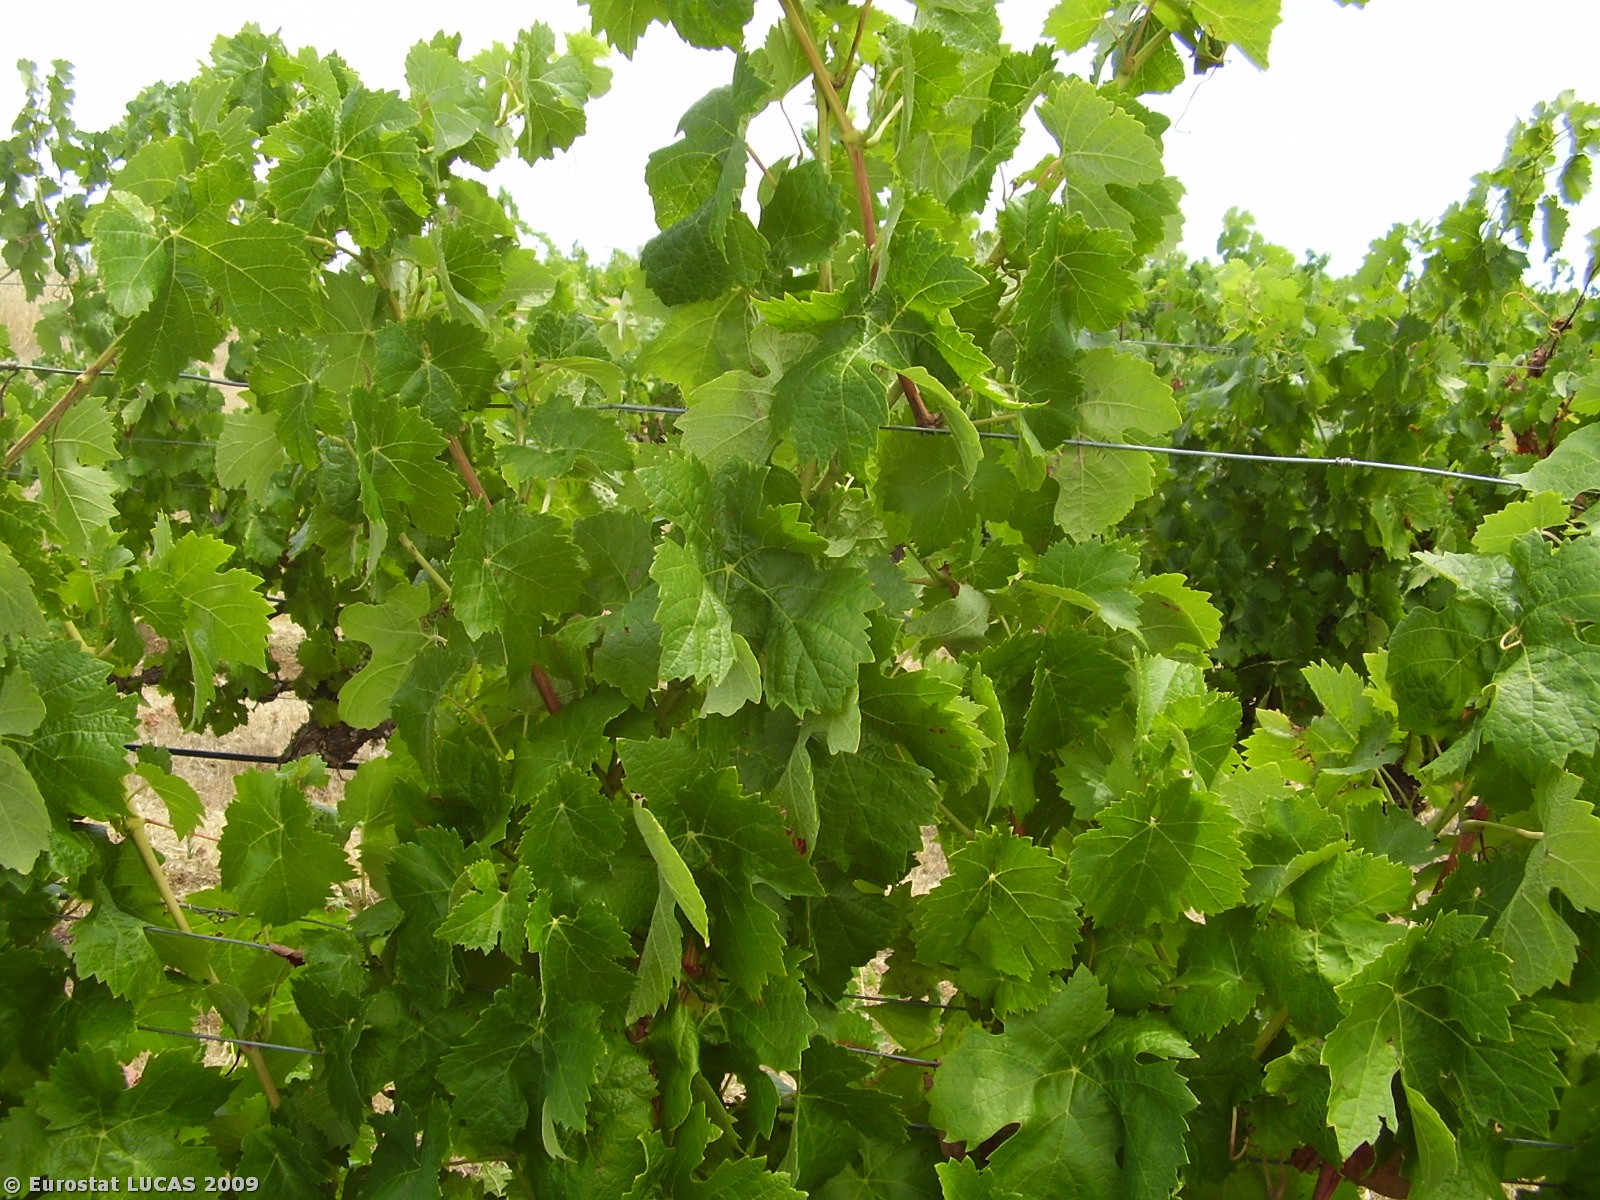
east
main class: Cropland
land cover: Vineyards
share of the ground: 10 - 25 %
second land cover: Spontaneously vegetated surfaces
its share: 50 - 75 %
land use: Agriculture (excluding fallow land and kitchen gardens)
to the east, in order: Vineyards; Spontaneously vegetated surfaces; Vineyards; Spontaneously vegetated surfaces; Tracks; Spontaneously vegetated surfaces; Fences; Spontaneously vegetated surfaces; Railways; Electric lines; Spontaneously vegetated surfaces; Fences; Grass margins; Oats; Grass margins; Fences; Spontaneously vegetated surfaces
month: July
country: PT
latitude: 38.5581
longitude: -7.8597
